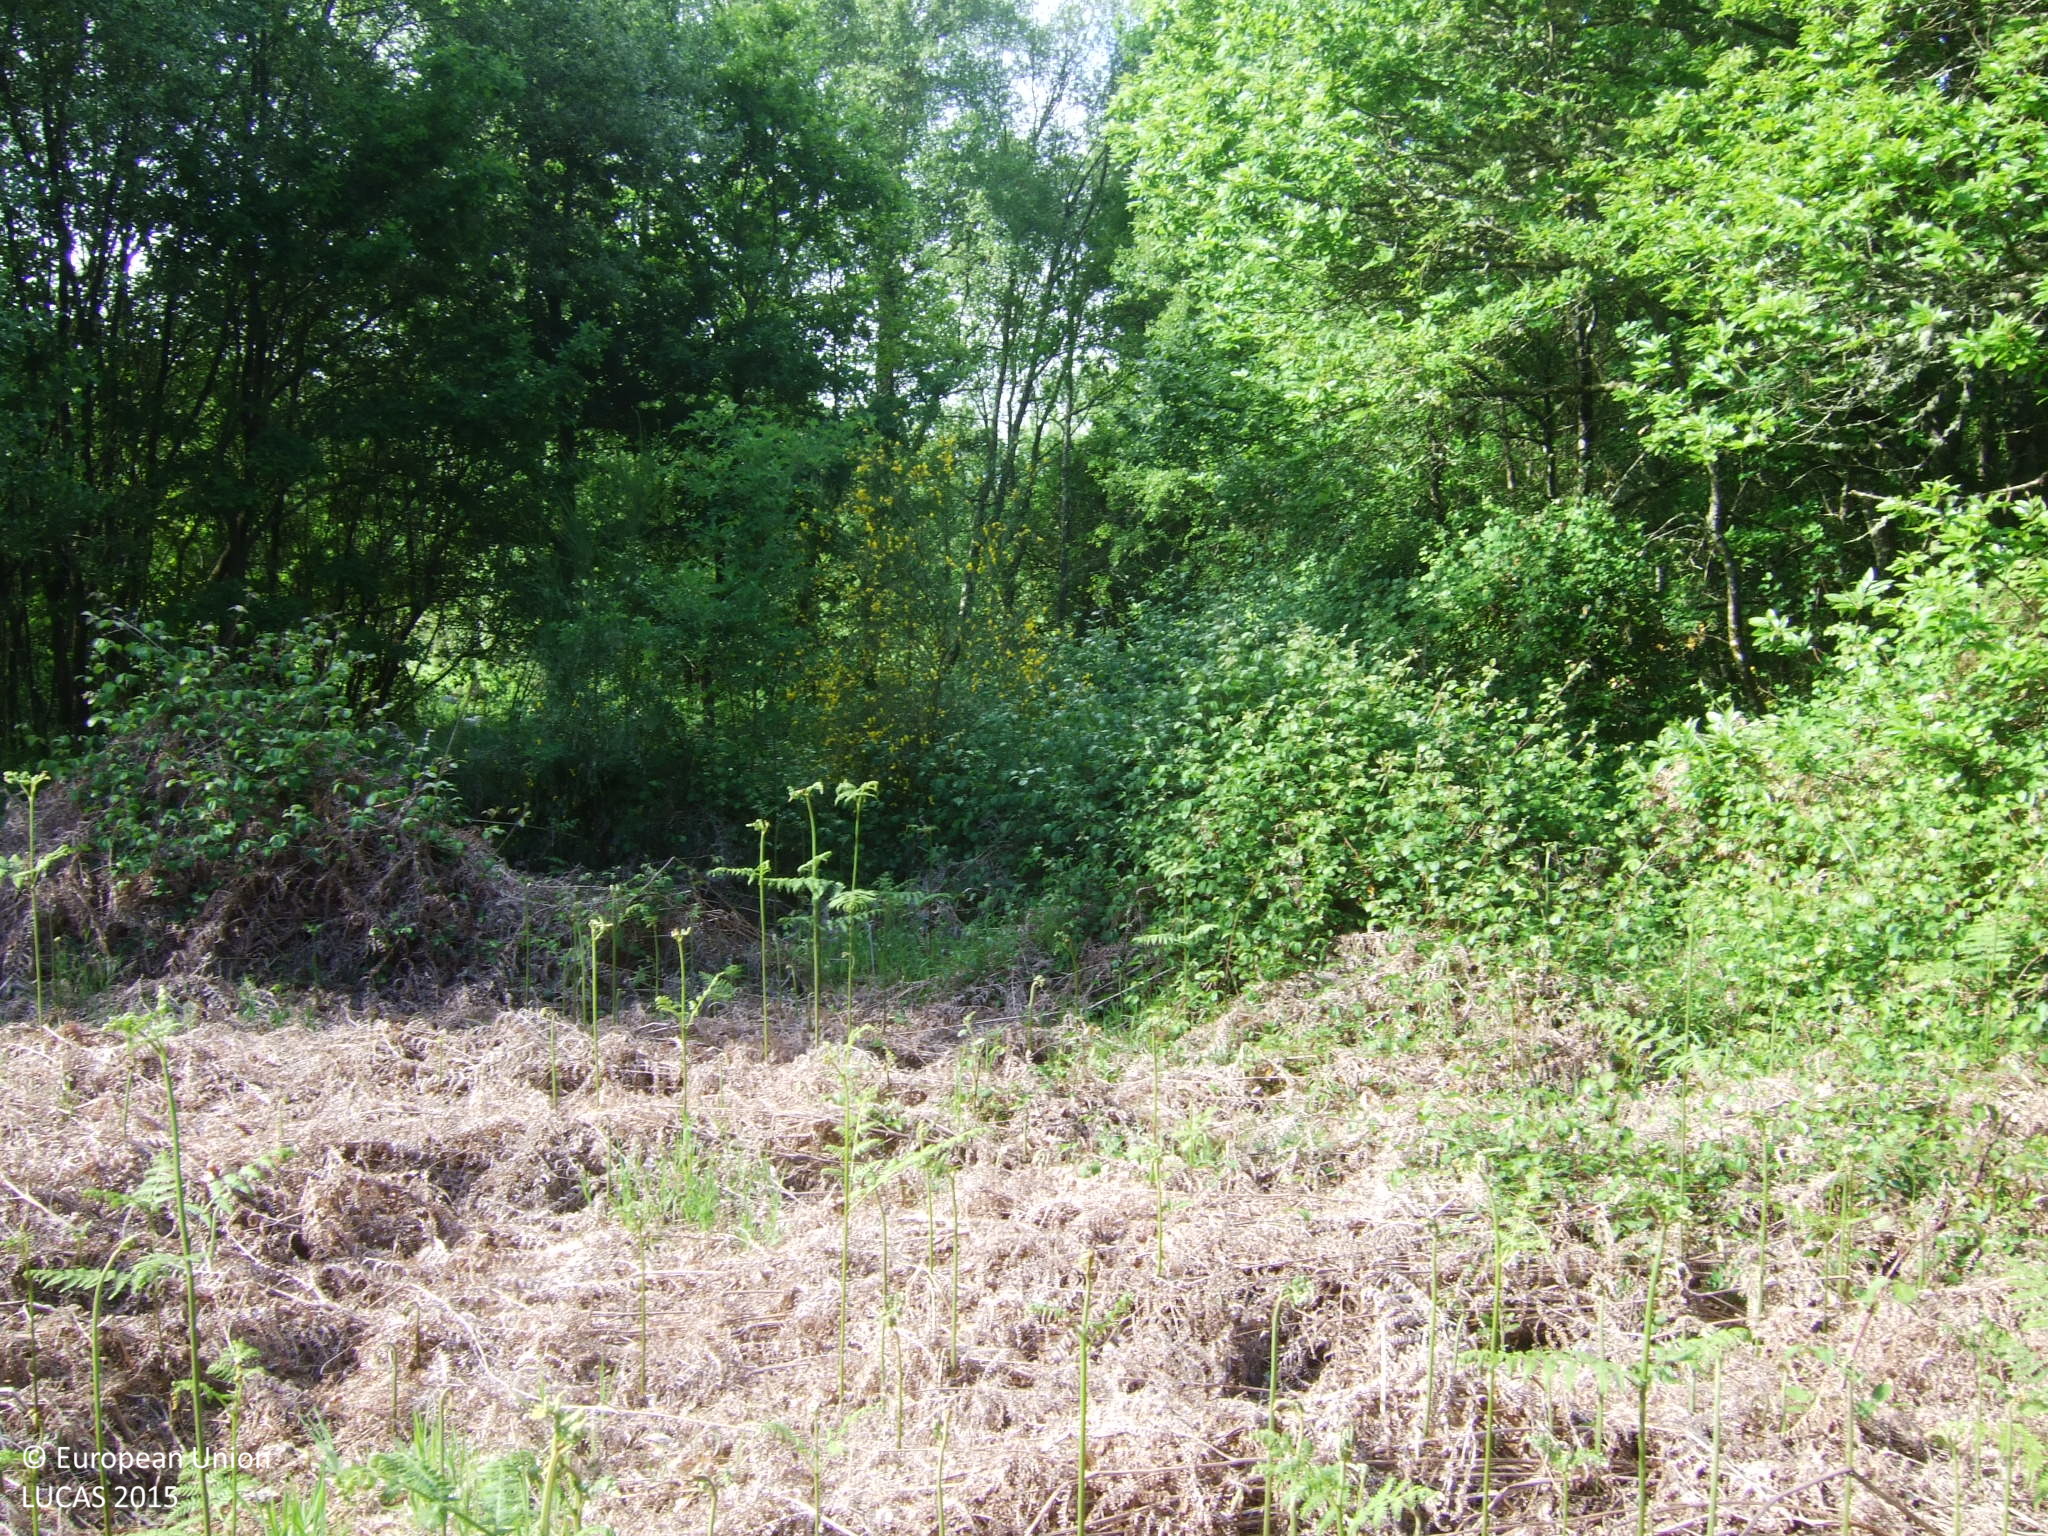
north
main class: Grassland
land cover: Grassland without tree/shrub cover
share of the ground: > 75 %
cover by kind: herbaceous plants 95 %, shrubs 5 %
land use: Agriculture (excluding fallow land and kitchen gardens)
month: May
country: ES
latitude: 43.3334
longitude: -7.7865
